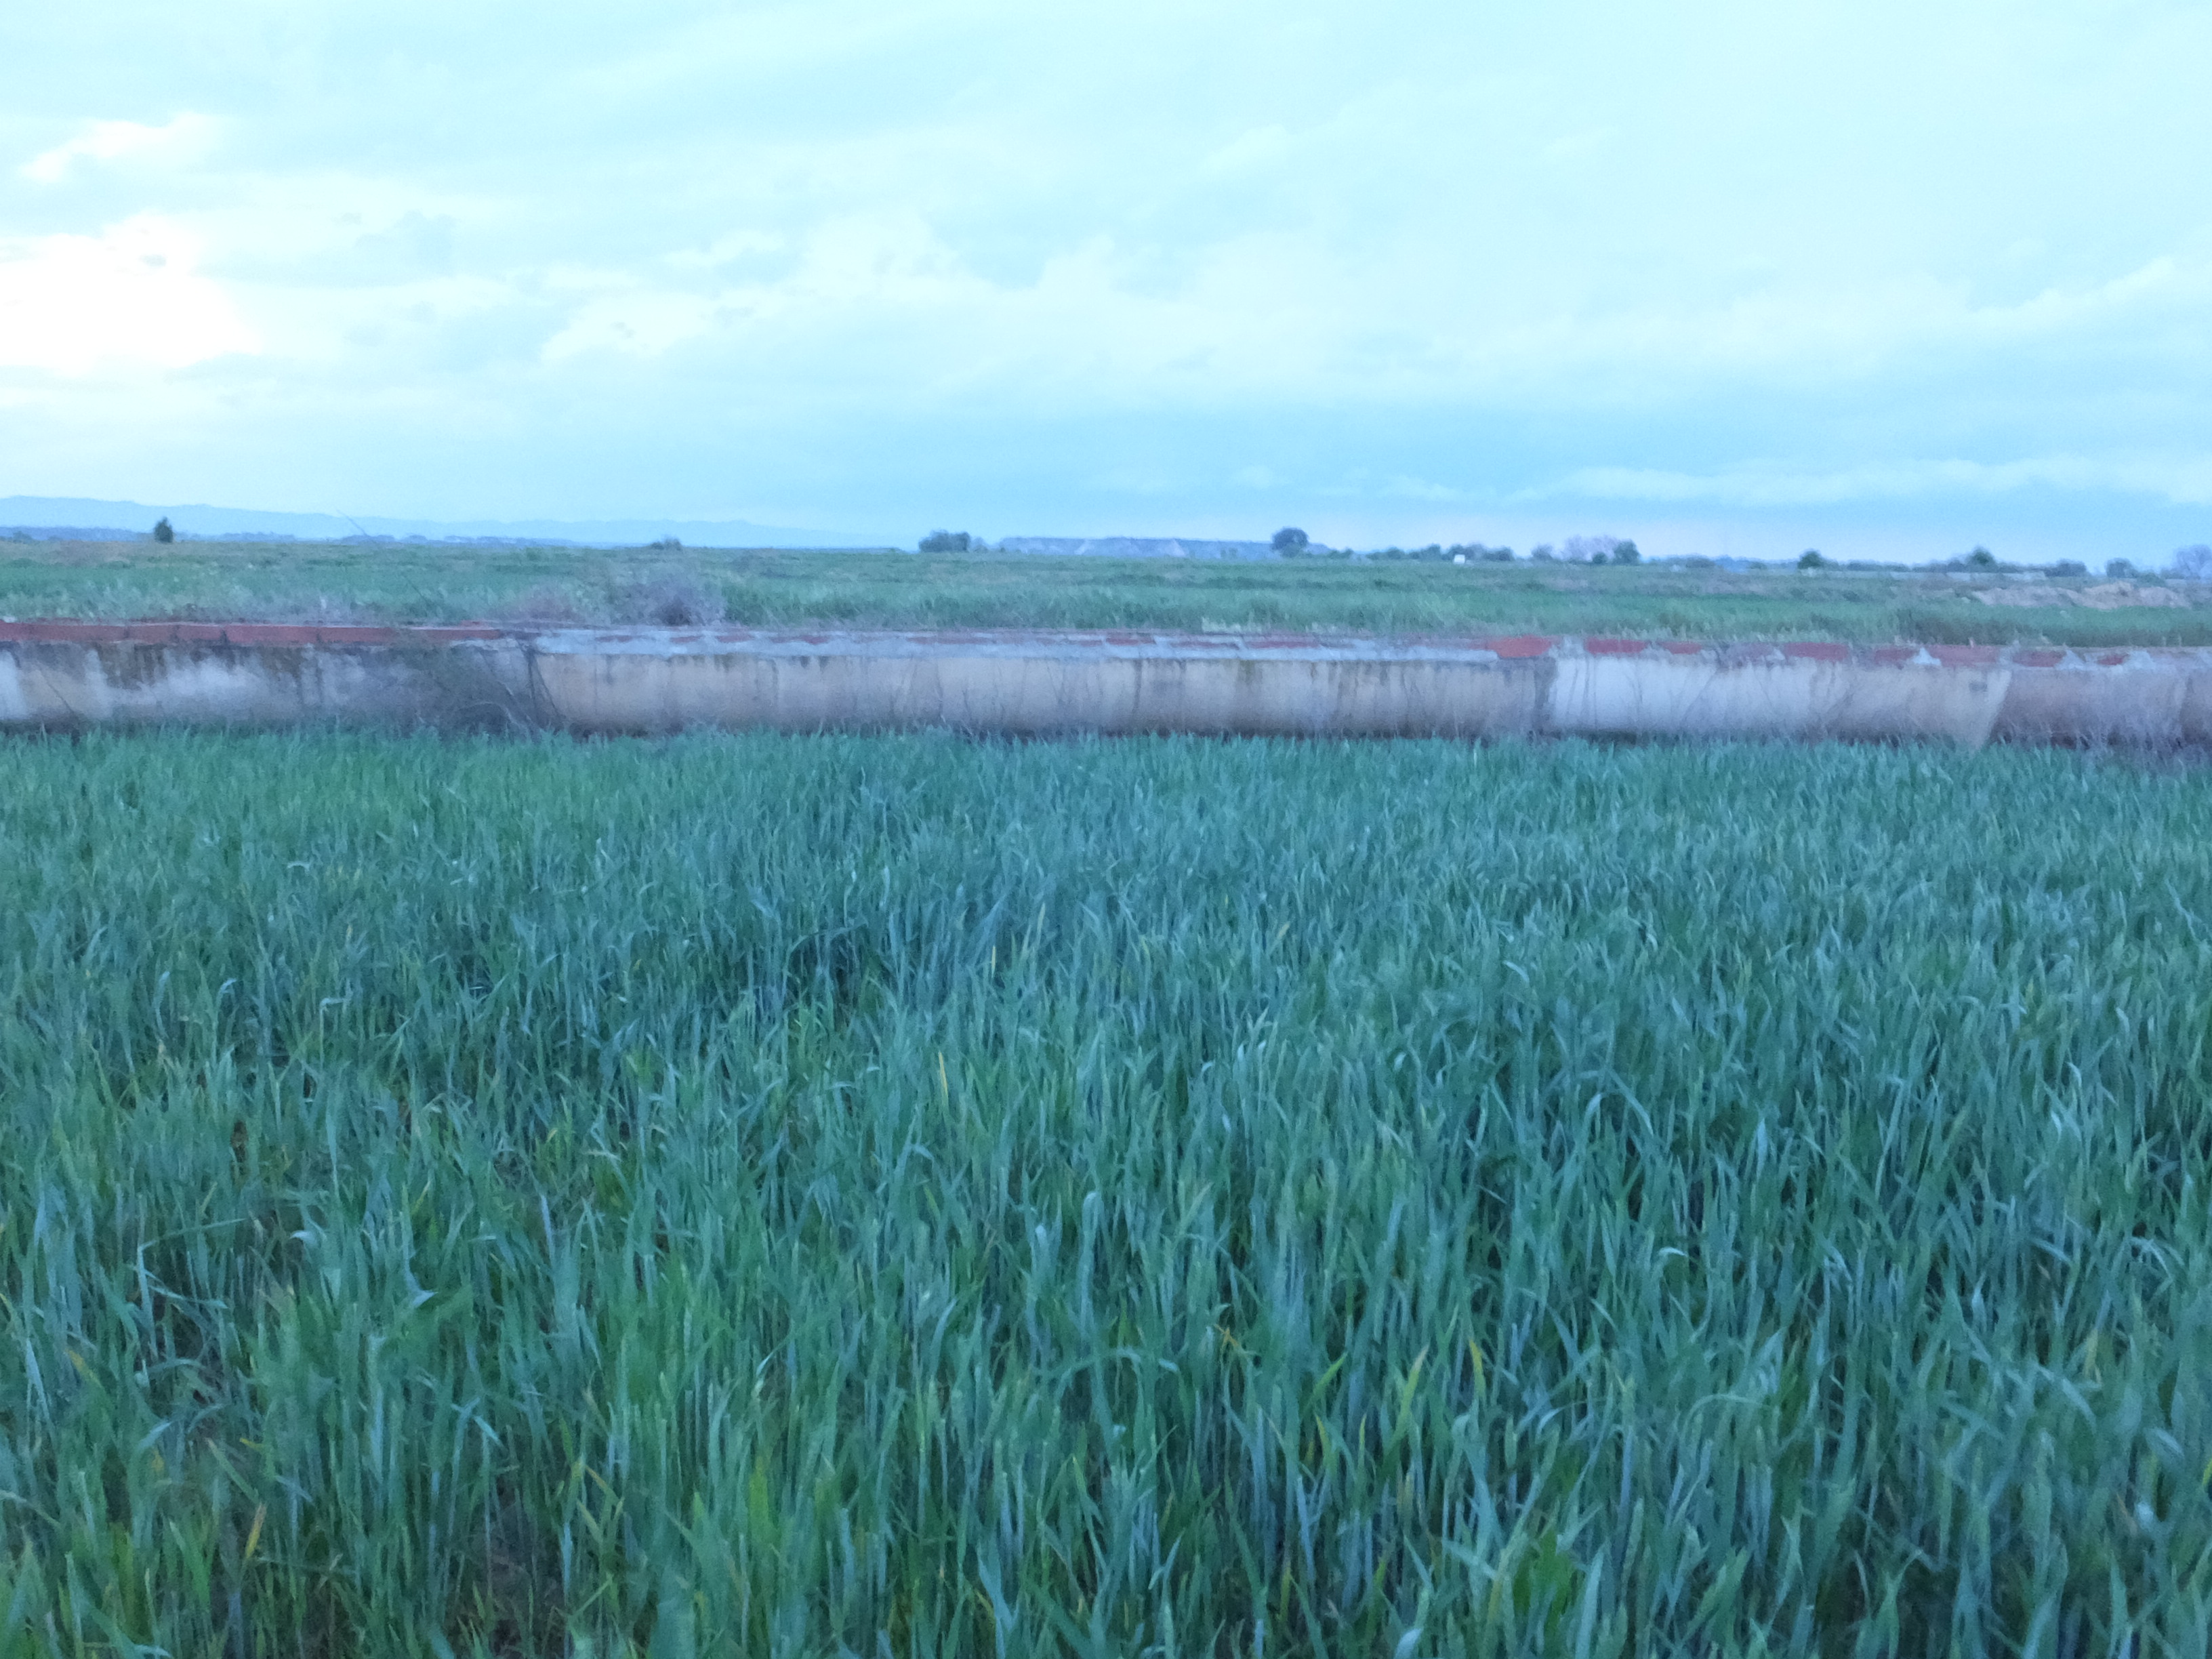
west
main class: Cropland
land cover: Common wheat
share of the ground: > 75 %
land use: Agriculture (excluding fallow land and kitchen gardens)
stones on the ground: < 10 %
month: April
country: ES
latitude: 41.7886
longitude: -0.2345
